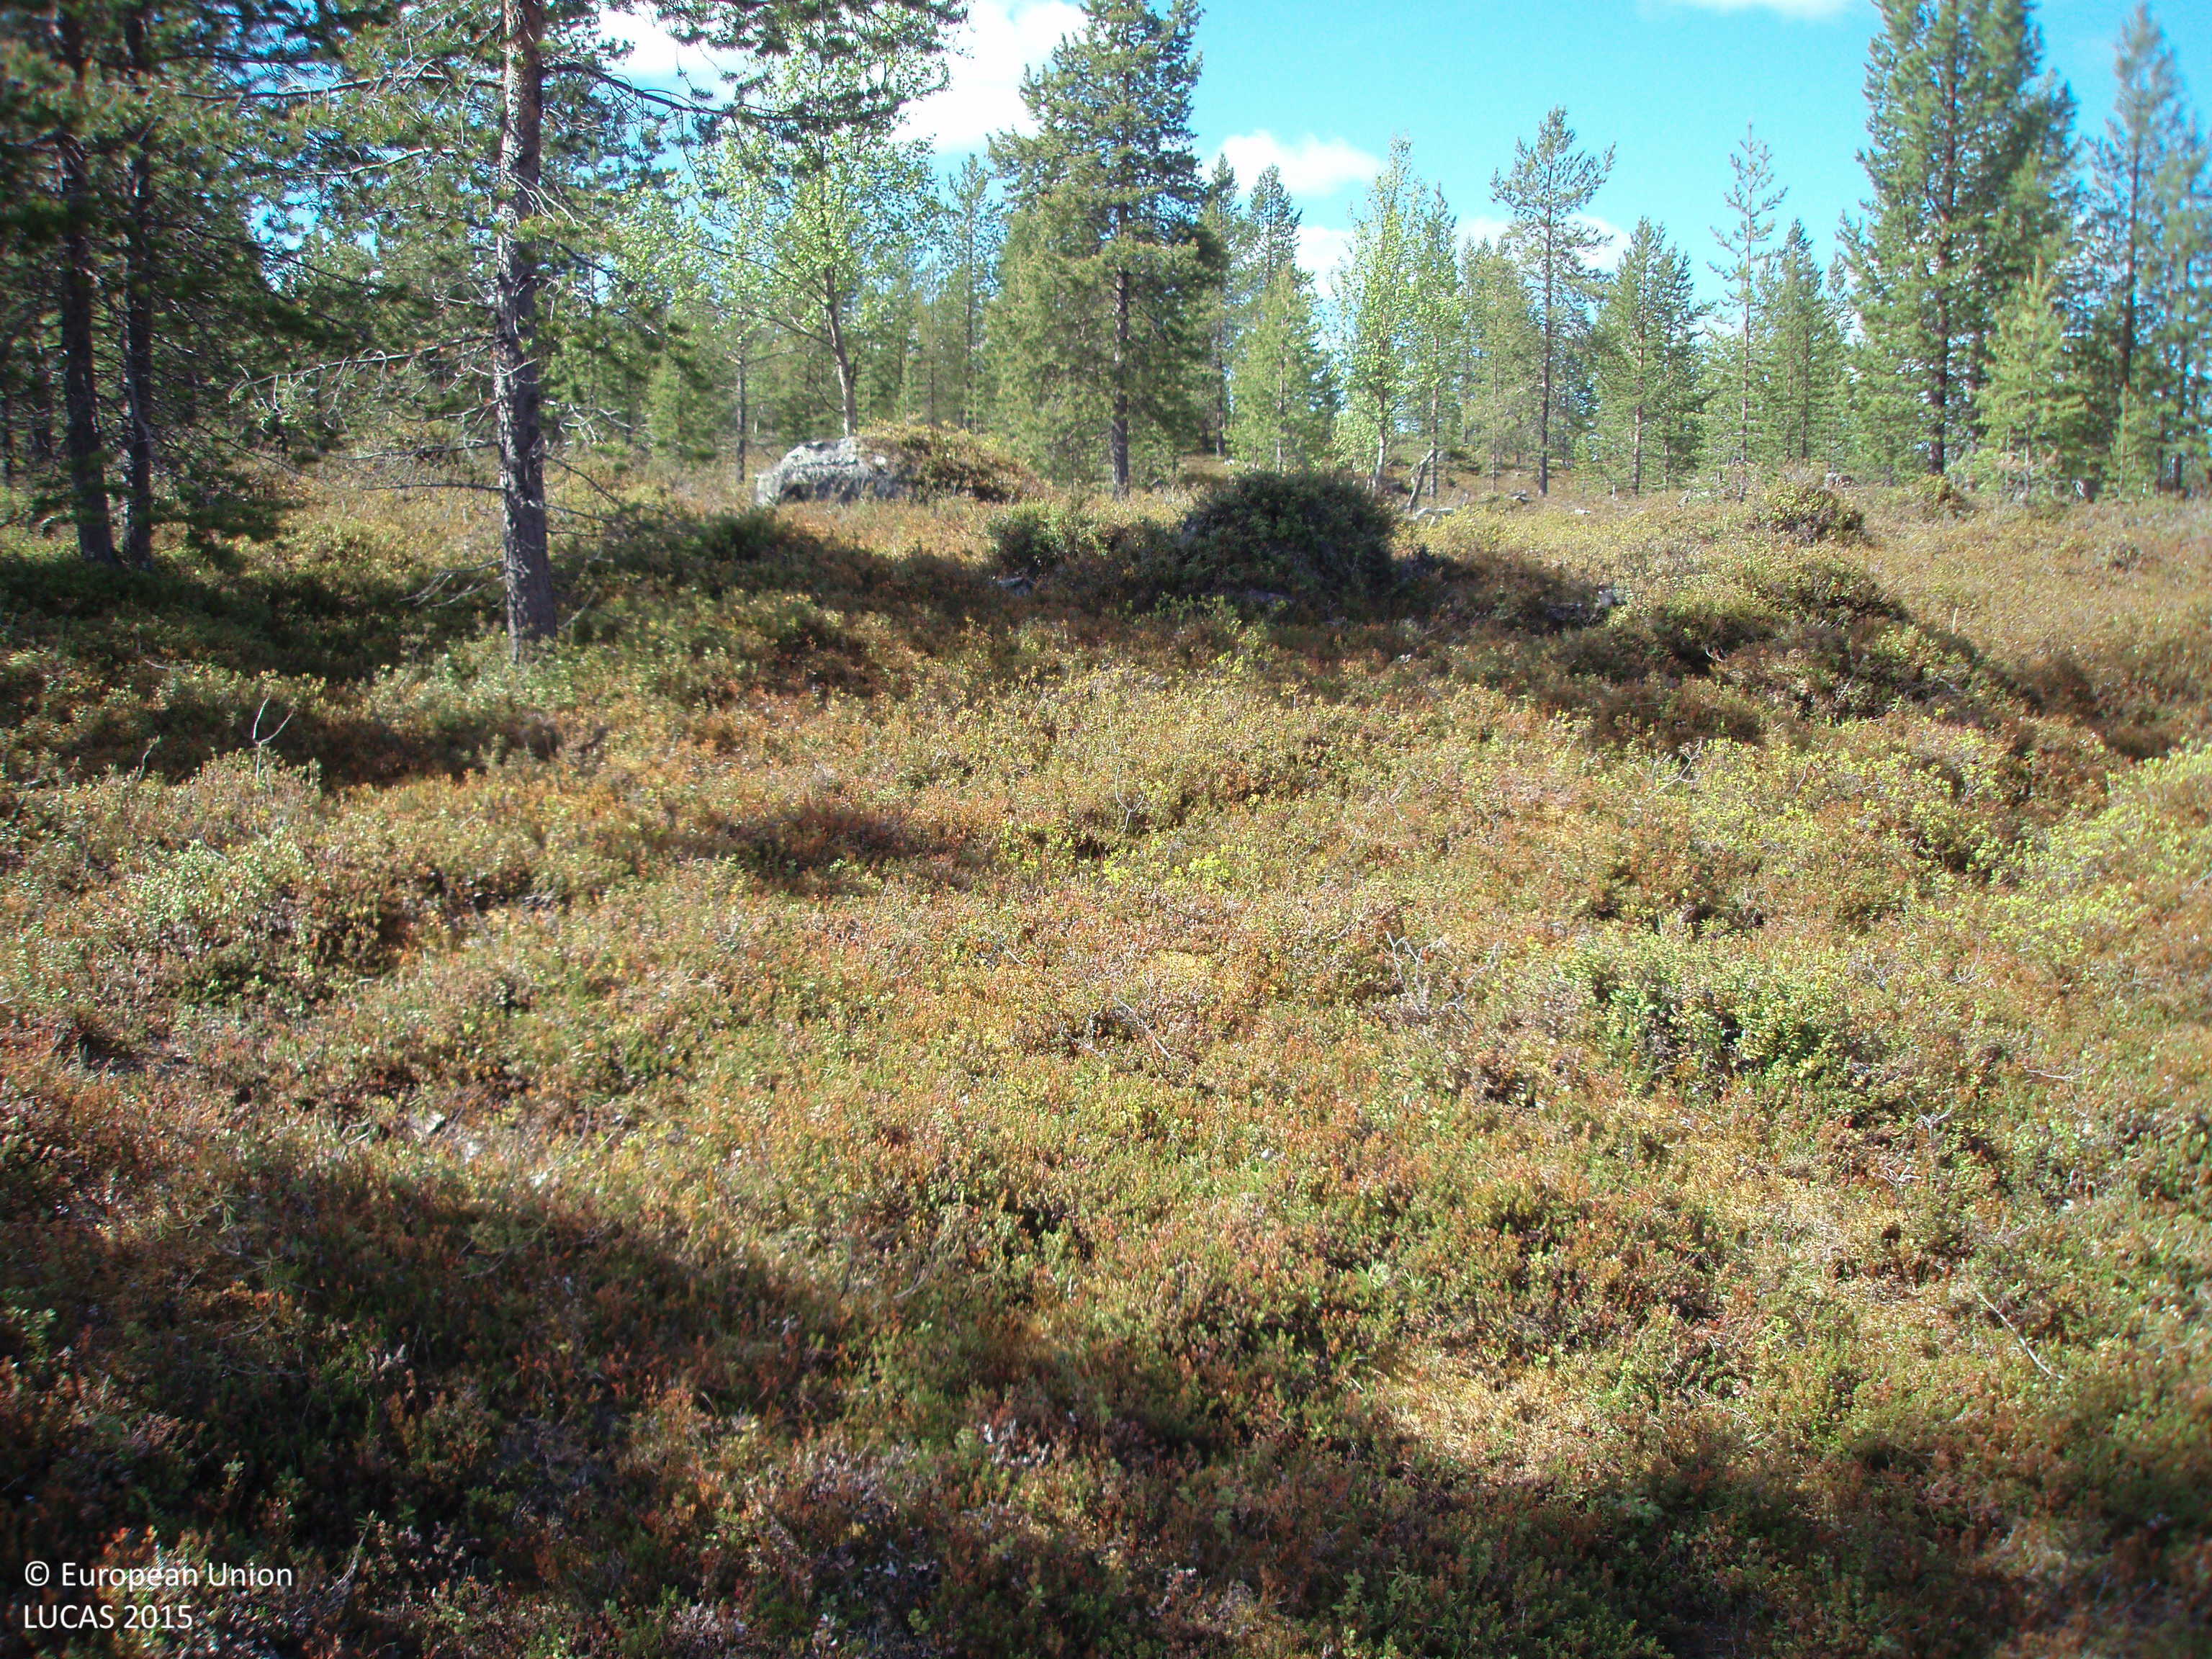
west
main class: Woodland
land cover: Pine dominated coniferous woodland
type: boreal forest
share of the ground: 25 - 50 %
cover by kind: shrubs 50 %, coniferous forest trees 35 %, lichens and mosses 10 %, broadleaved forest trees 5 %
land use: Forestry
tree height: > 5 m
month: June
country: FI
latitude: 68.6269
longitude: 28.0168
